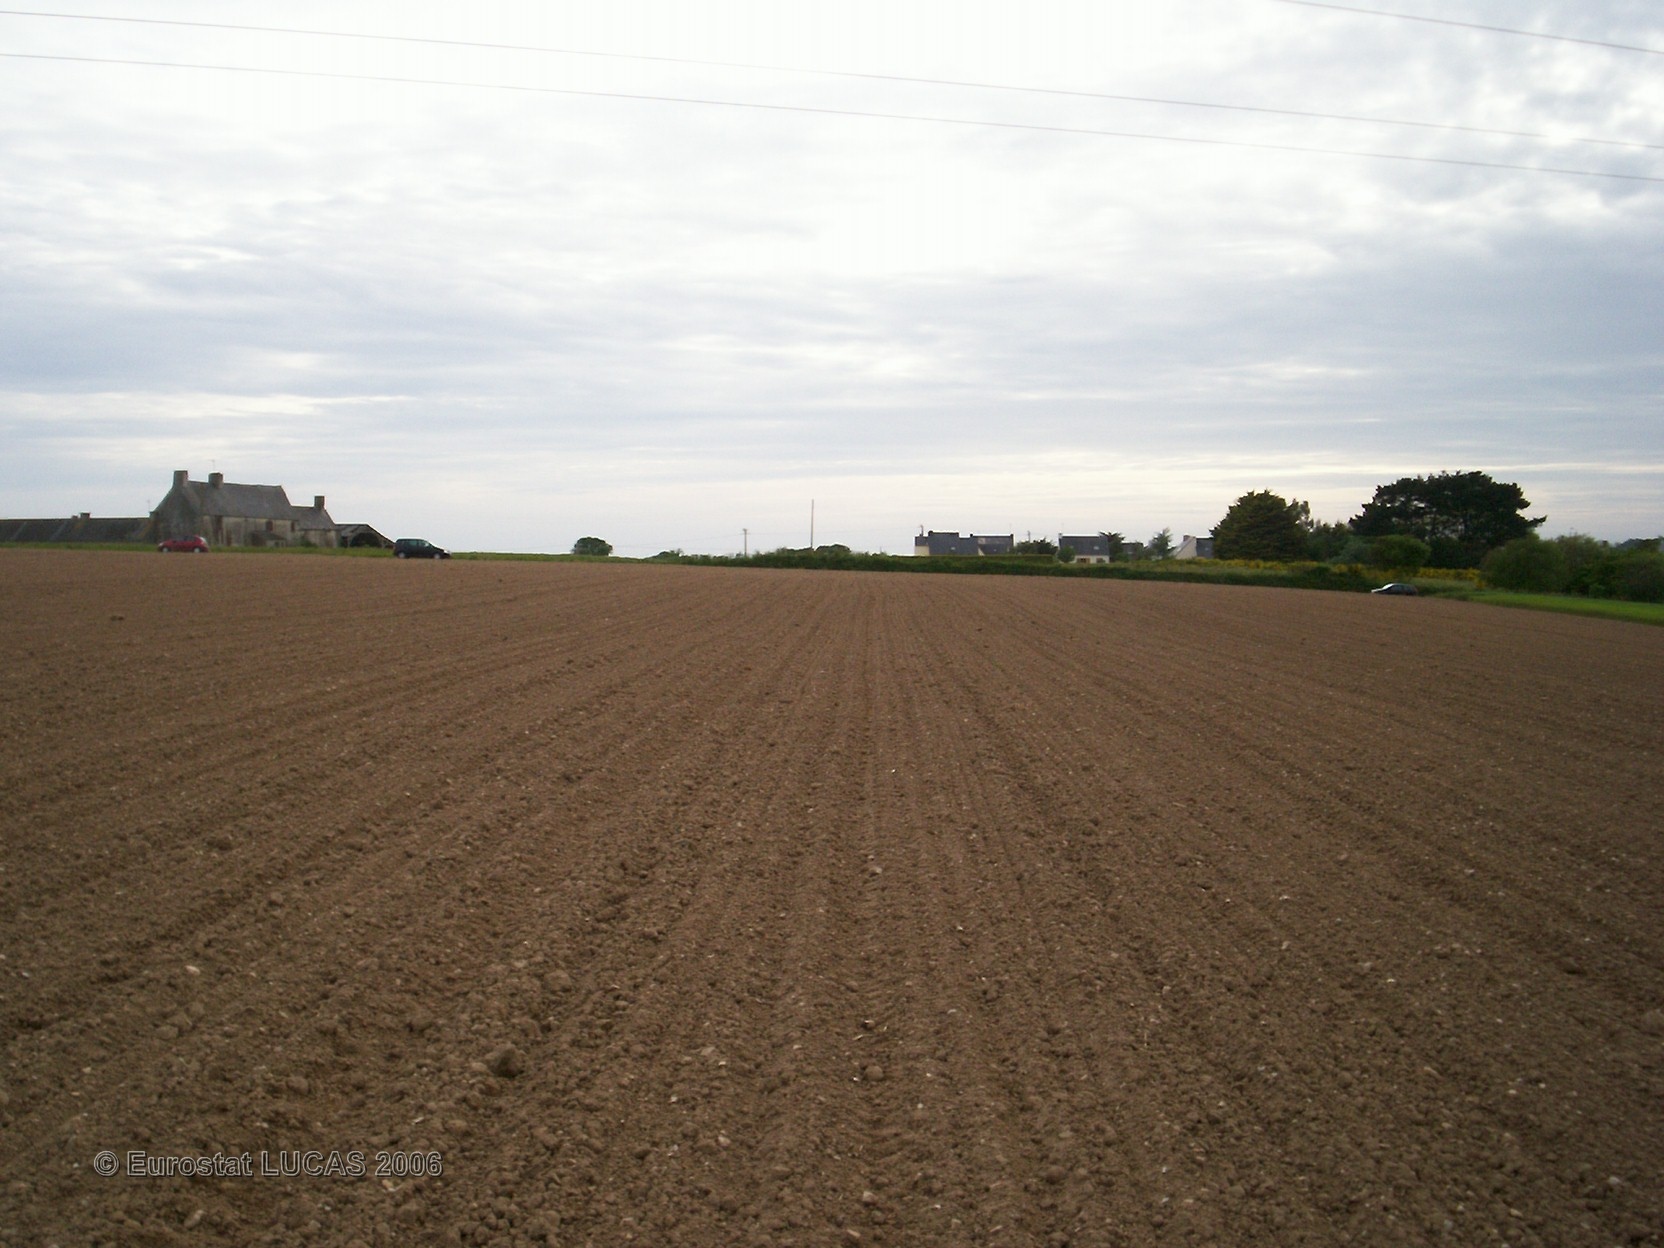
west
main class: Cropland
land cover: Maize
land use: Agriculture (excluding fallow land and kitchen gardens)
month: May
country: FR
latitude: 47.7732
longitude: -3.4862
